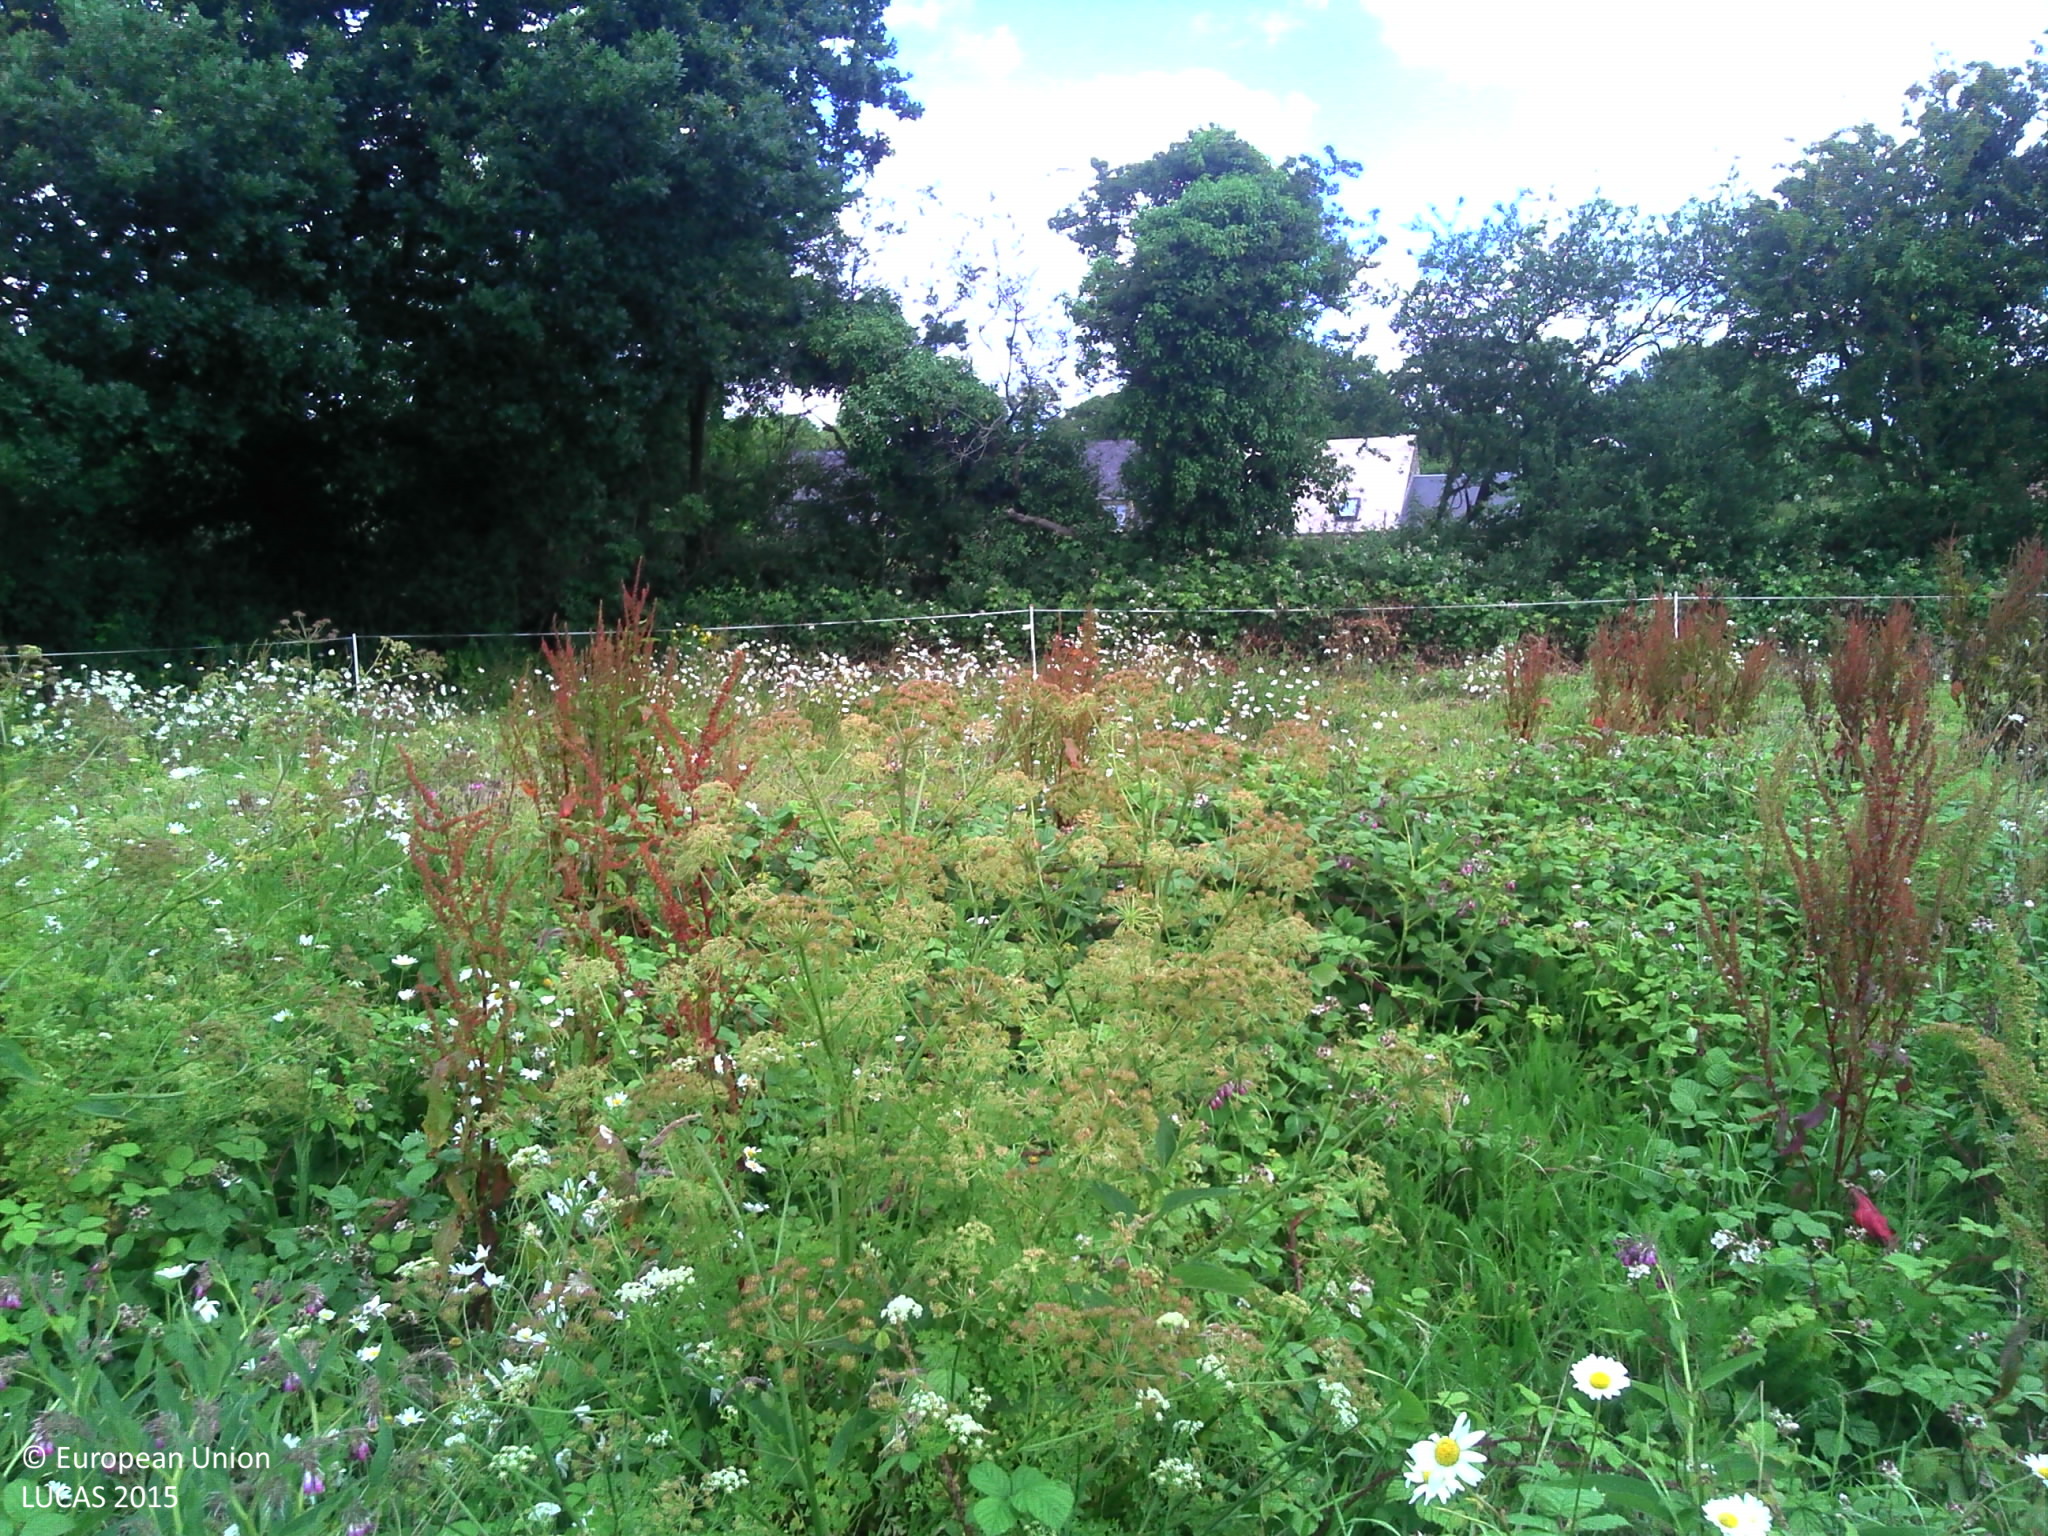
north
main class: Grassland
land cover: Grassland without tree/shrub cover
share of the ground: > 75 %
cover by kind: herbaceous plants 100 %
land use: Agriculture (excluding fallow land and kitchen gardens)
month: June
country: FR
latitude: 49.3656
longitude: -1.6597
